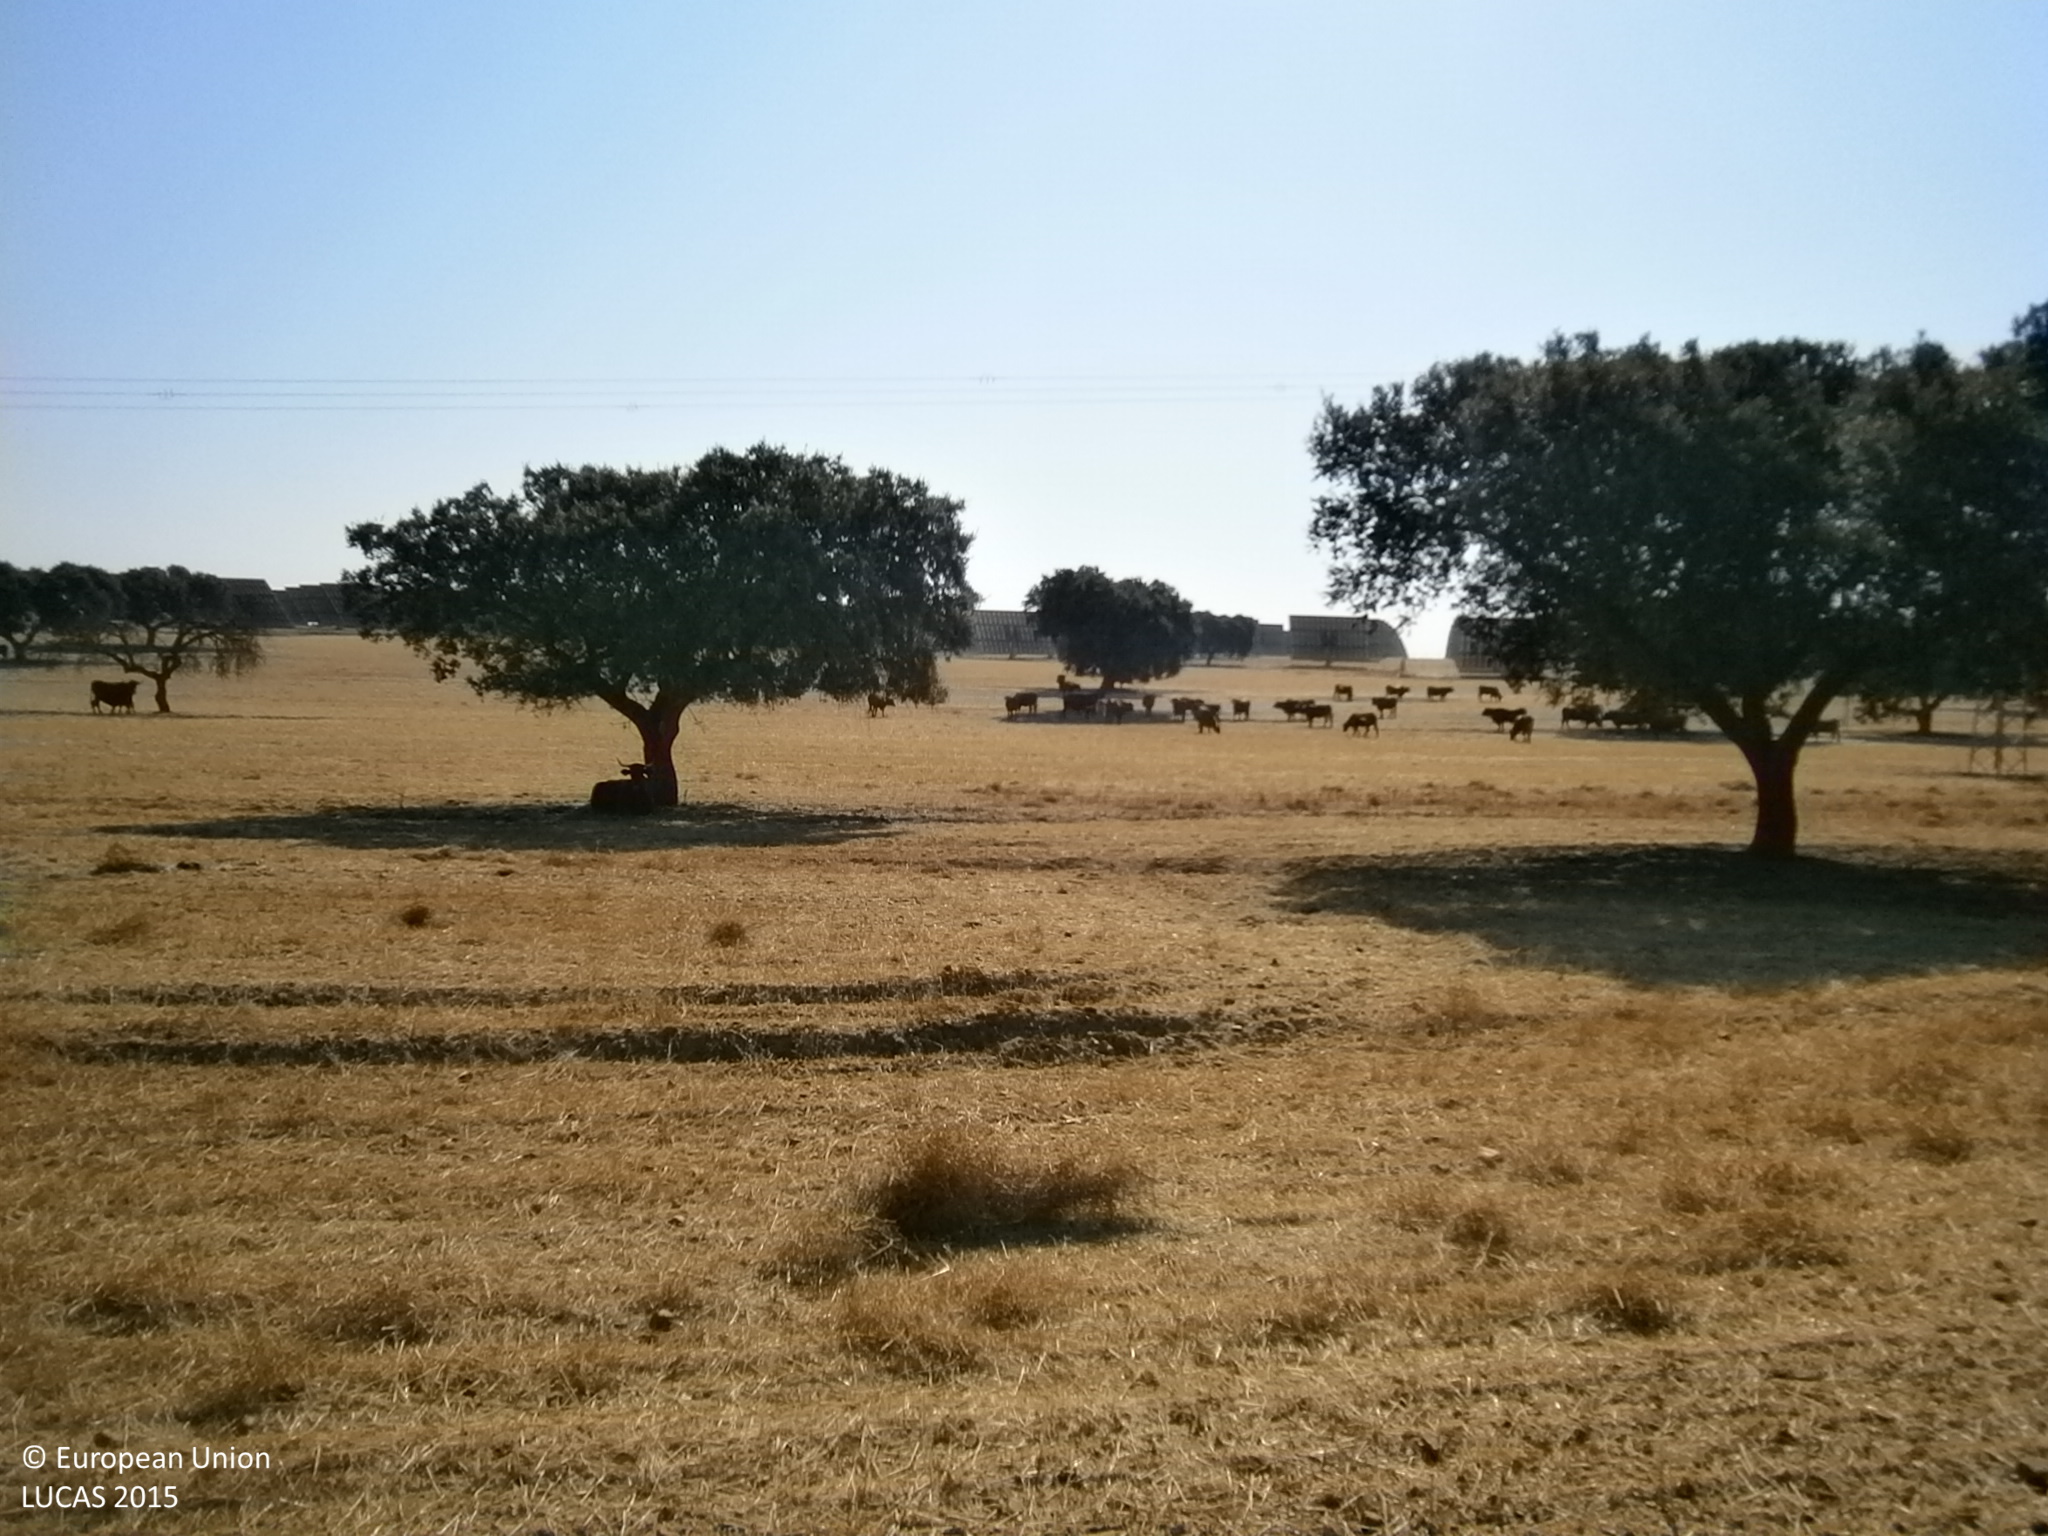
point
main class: Grassland
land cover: Grassland without tree/shrub cover
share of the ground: > 75 %
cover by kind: herbaceous plants 95 %, shrubs 5 %
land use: Agriculture (excluding fallow land and kitchen gardens)
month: June
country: ES
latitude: 38.8154
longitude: -6.7519
